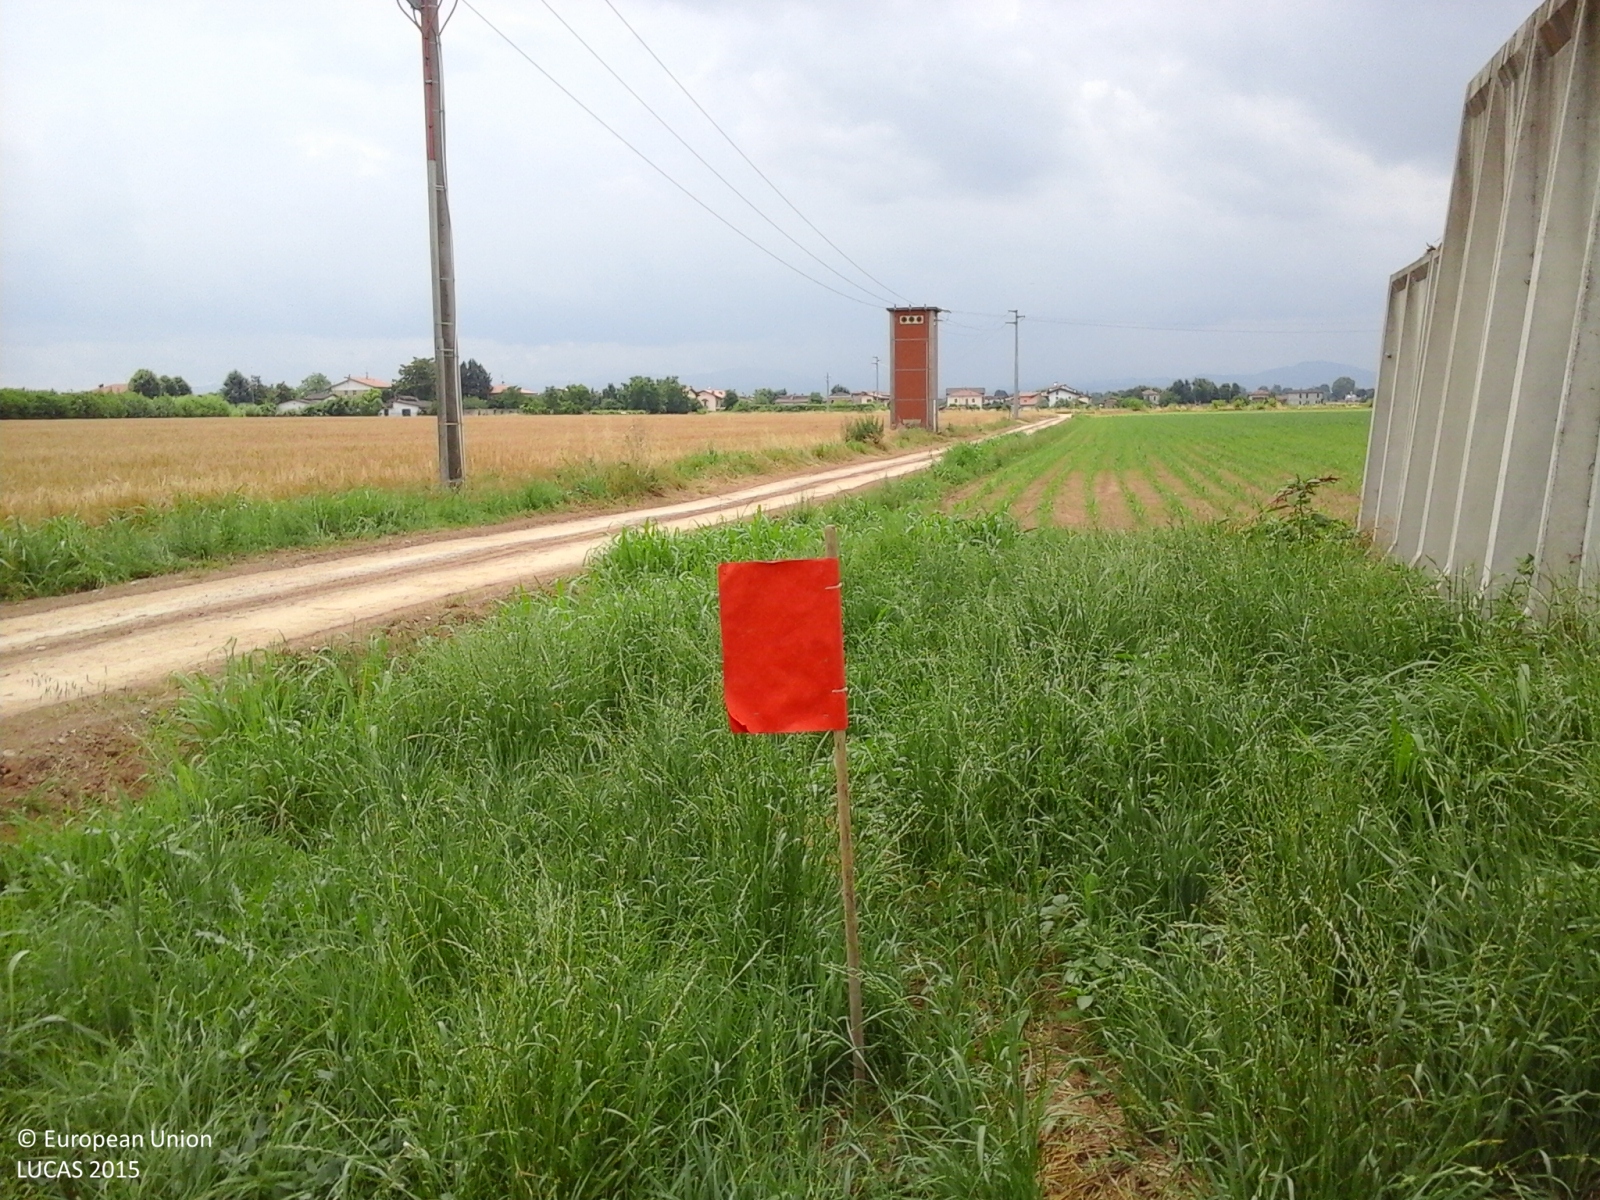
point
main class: Grassland
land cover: Grassland without tree/shrub cover
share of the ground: > 75 %
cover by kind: herbaceous plants 100 %
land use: Agriculture (excluding fallow land and kitchen gardens)
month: June
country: IT
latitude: 44.9812
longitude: 9.6836
